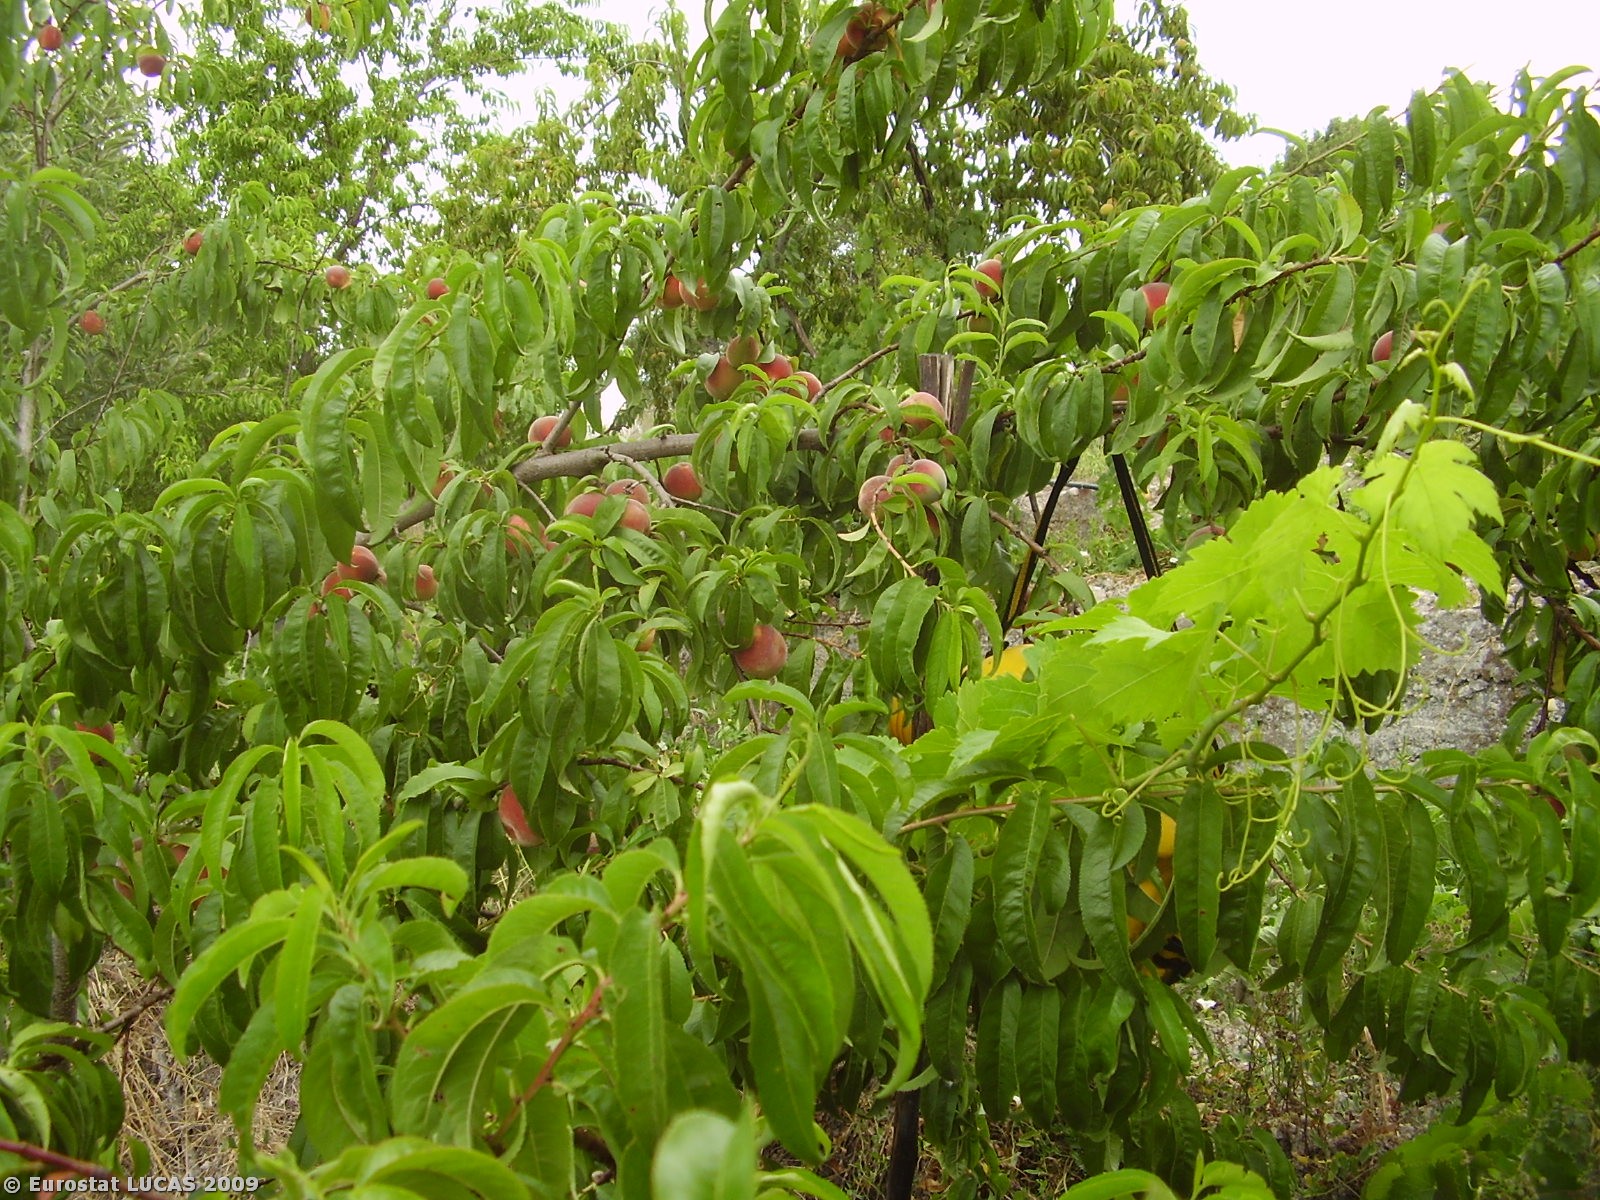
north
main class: Cropland
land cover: Olive groves
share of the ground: 10 - 25 %
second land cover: Shrubland with sparse tree cover
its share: > 75 %
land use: Agriculture (excluding fallow land and kitchen gardens)
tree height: > 5 m
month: July
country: PT
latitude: 39.4882
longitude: -8.0233
